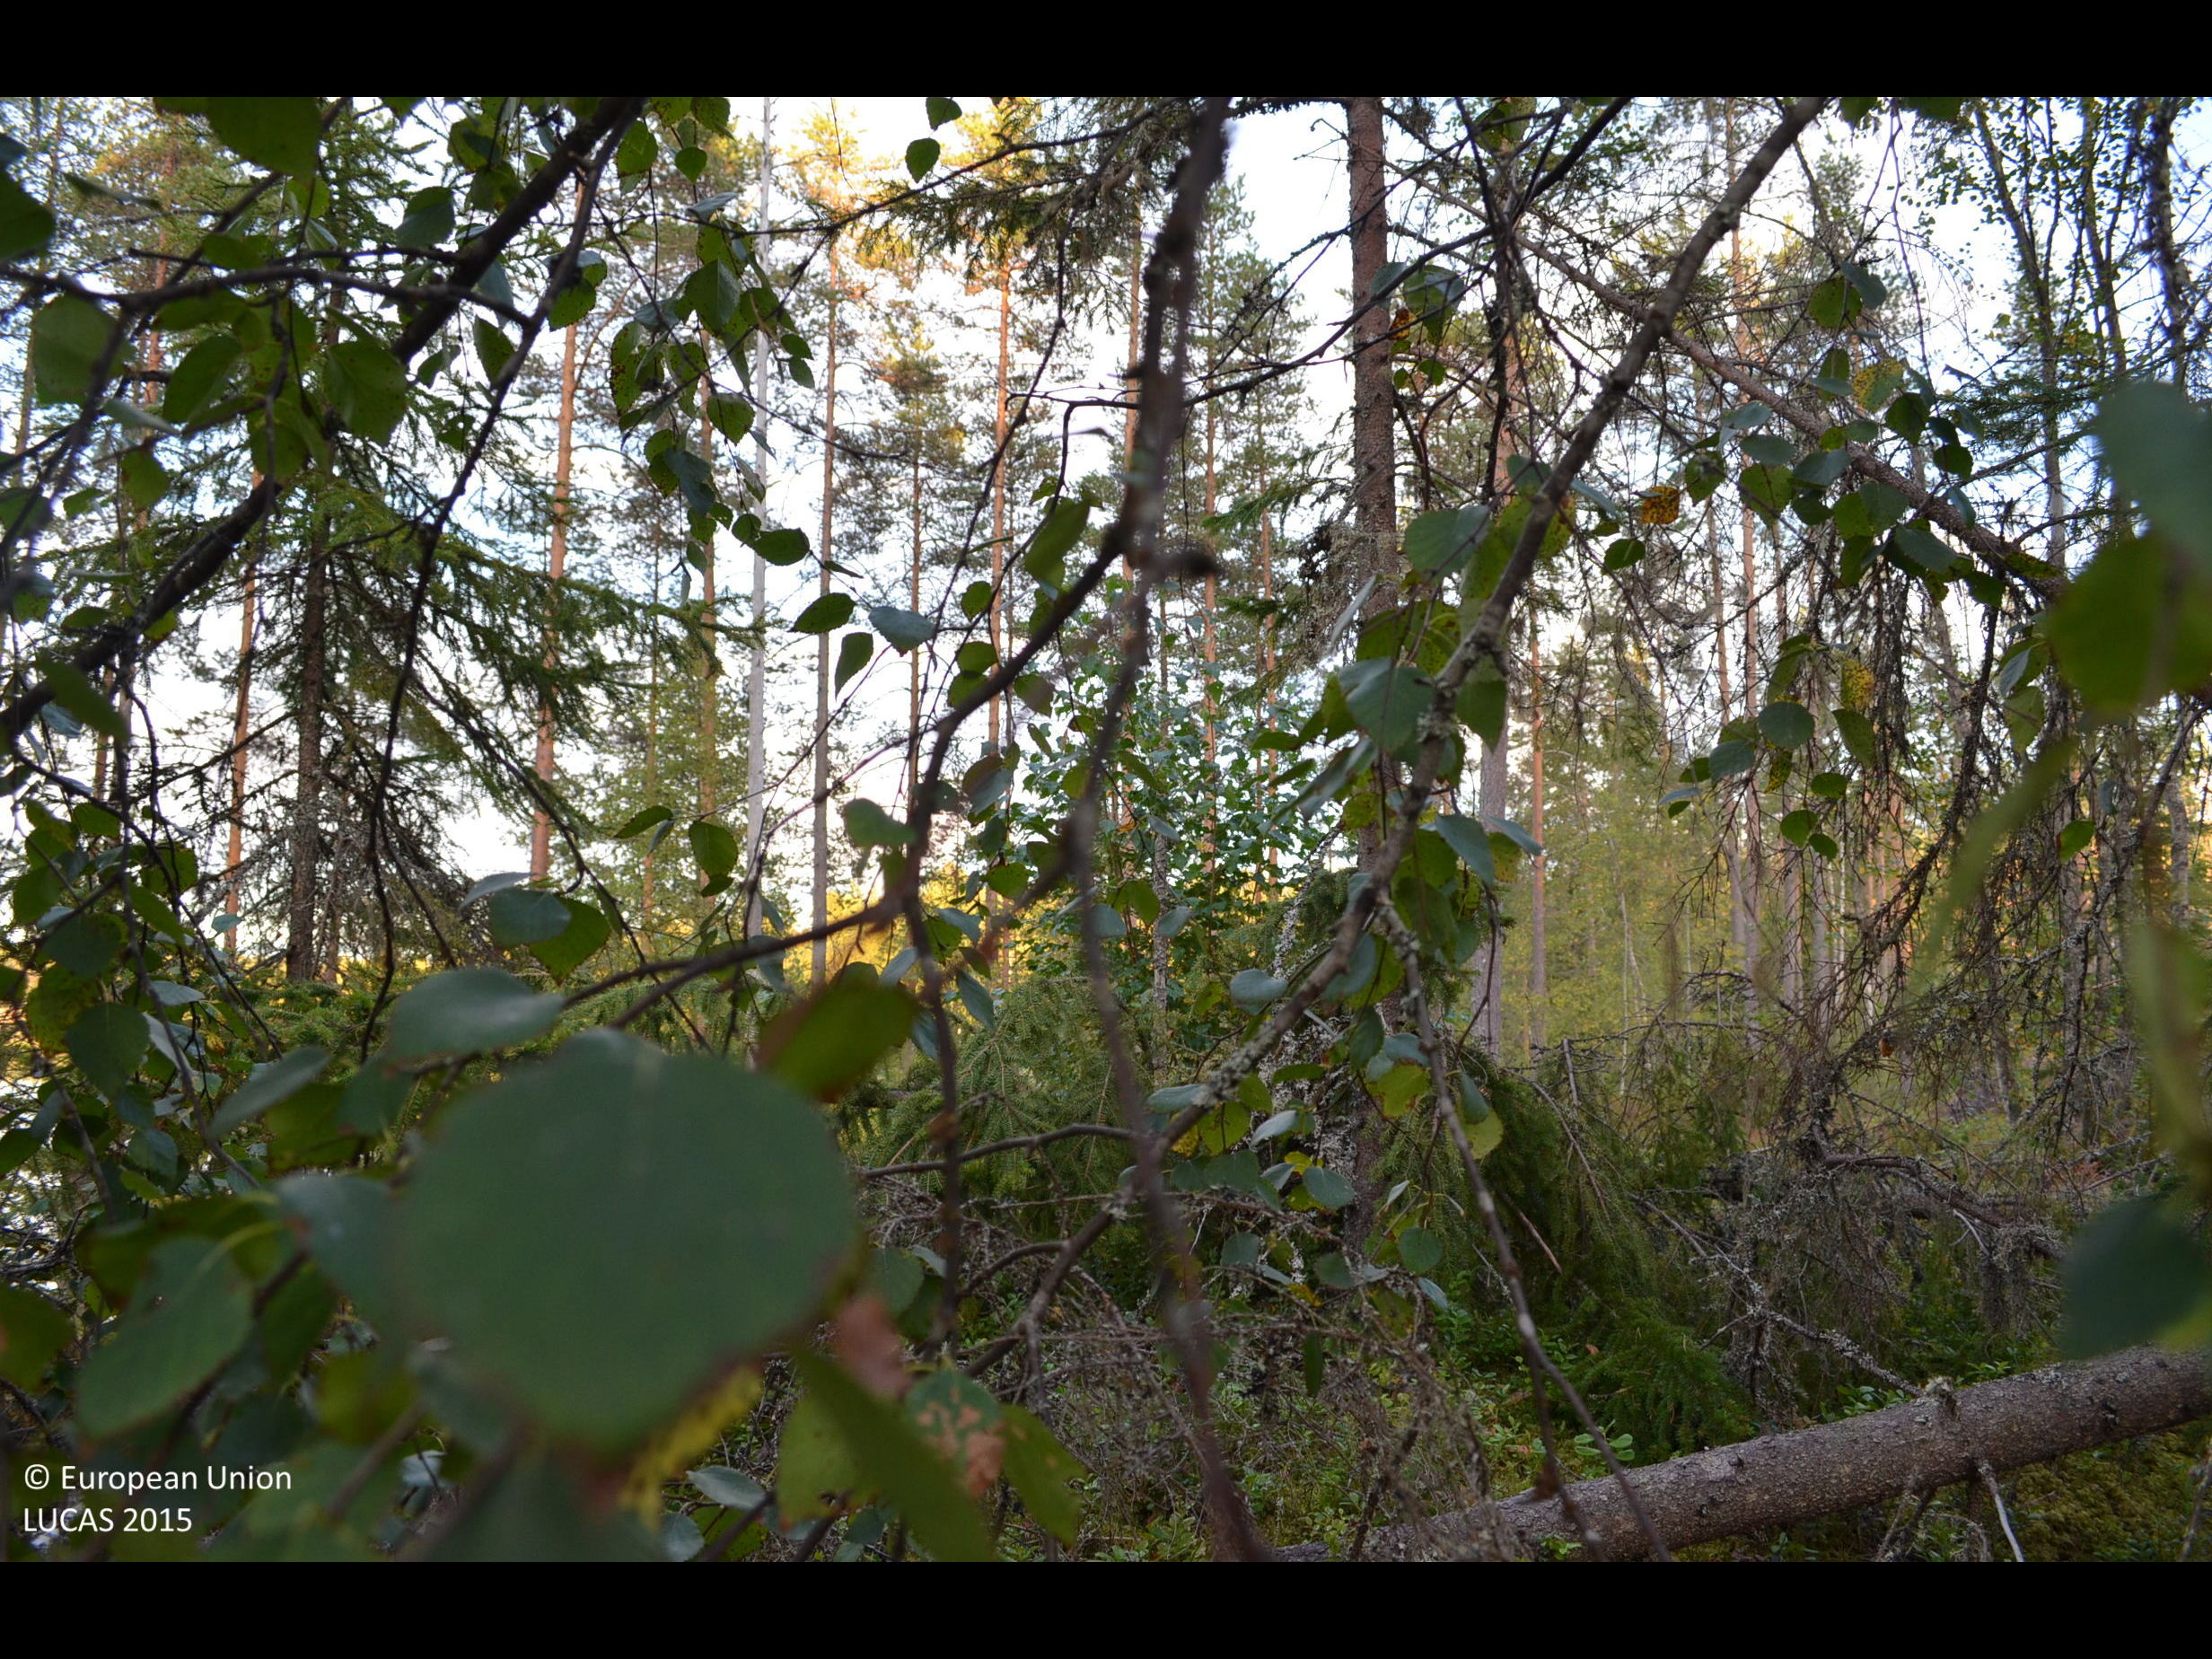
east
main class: Woodland
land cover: Other coniferous woodland
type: boreal forest
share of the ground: 50 - 75 %
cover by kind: coniferous forest trees 50 %, shrubs 30 %, broadleaved forest trees 10 %
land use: Forestry
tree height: > 5 m
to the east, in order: Other coniferous woodland; Pine dominated coniferous woodland; Inland fresh water bodies
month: August
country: FI
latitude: 62.4097
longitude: 23.6415
